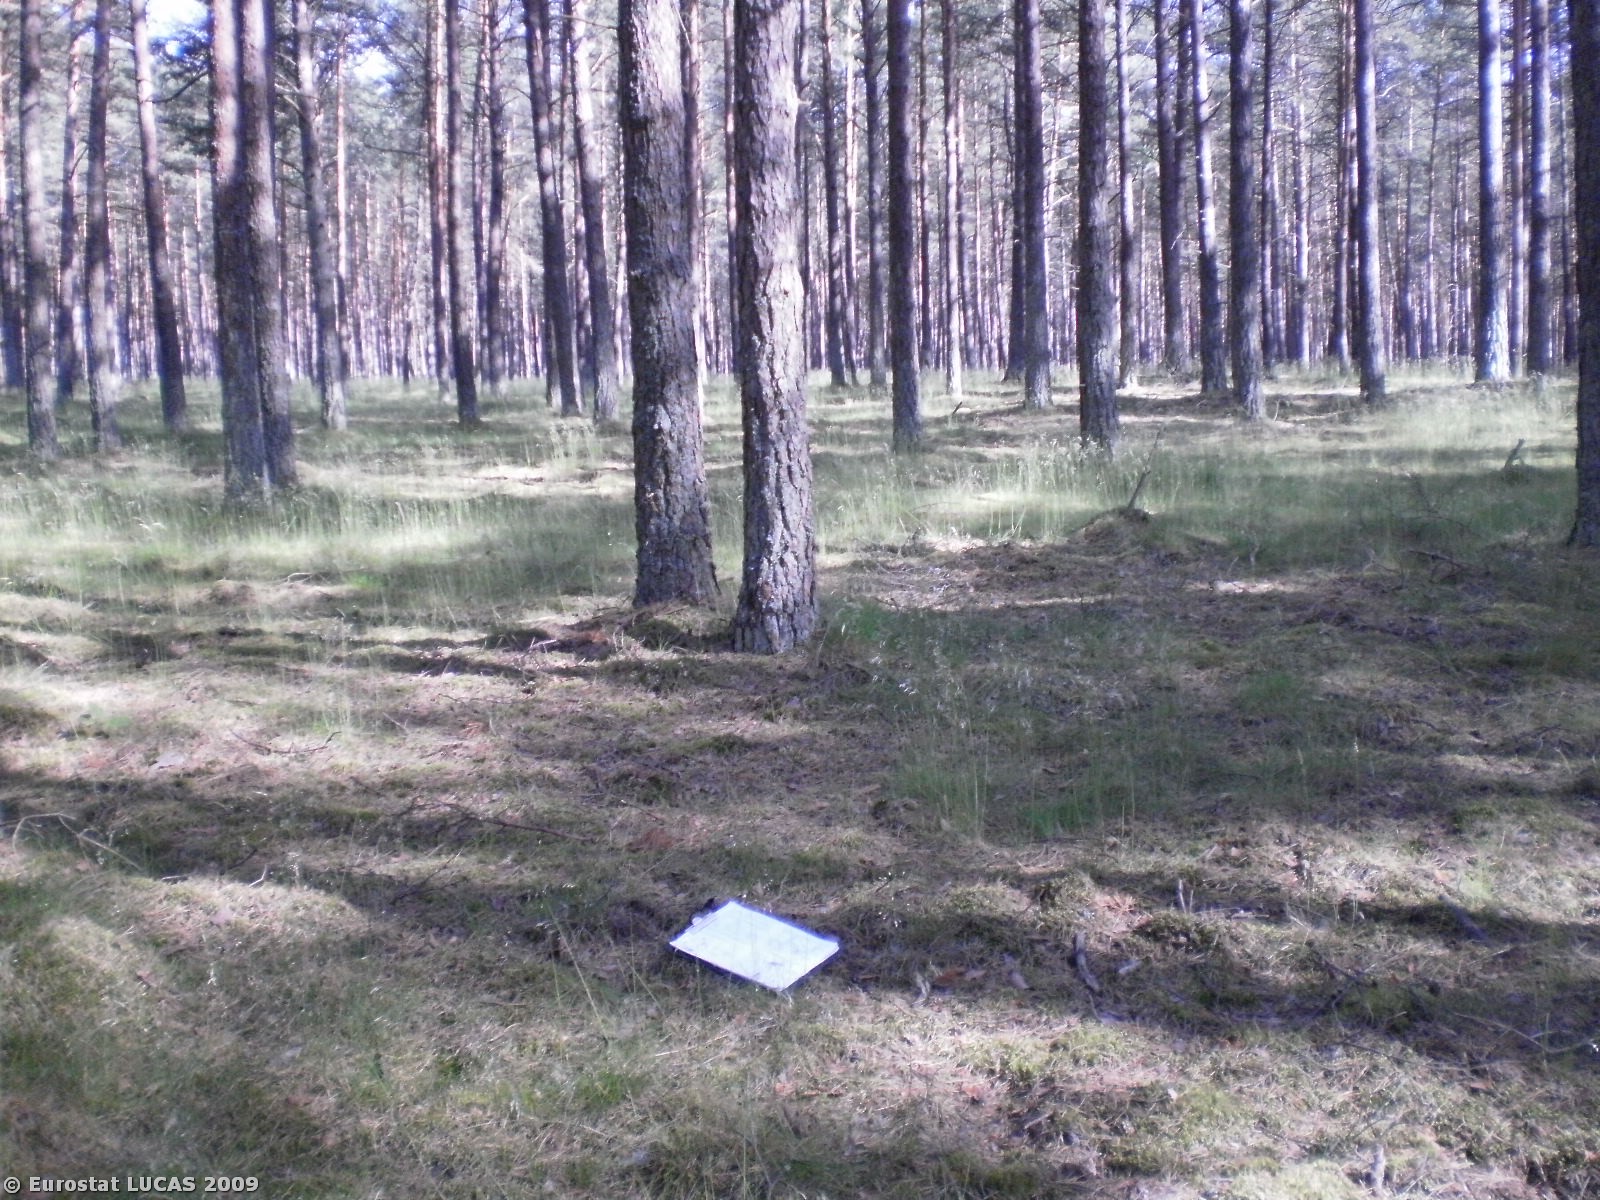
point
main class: Woodland
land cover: Coniferous woodland
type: hemiboreal forest and nemoral coniferous forest and mixed broadleaved-coniferous forest
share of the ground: > 75 %
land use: Forestry
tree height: > 5 m
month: June
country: PL
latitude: 54.1553
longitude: 17.8994
